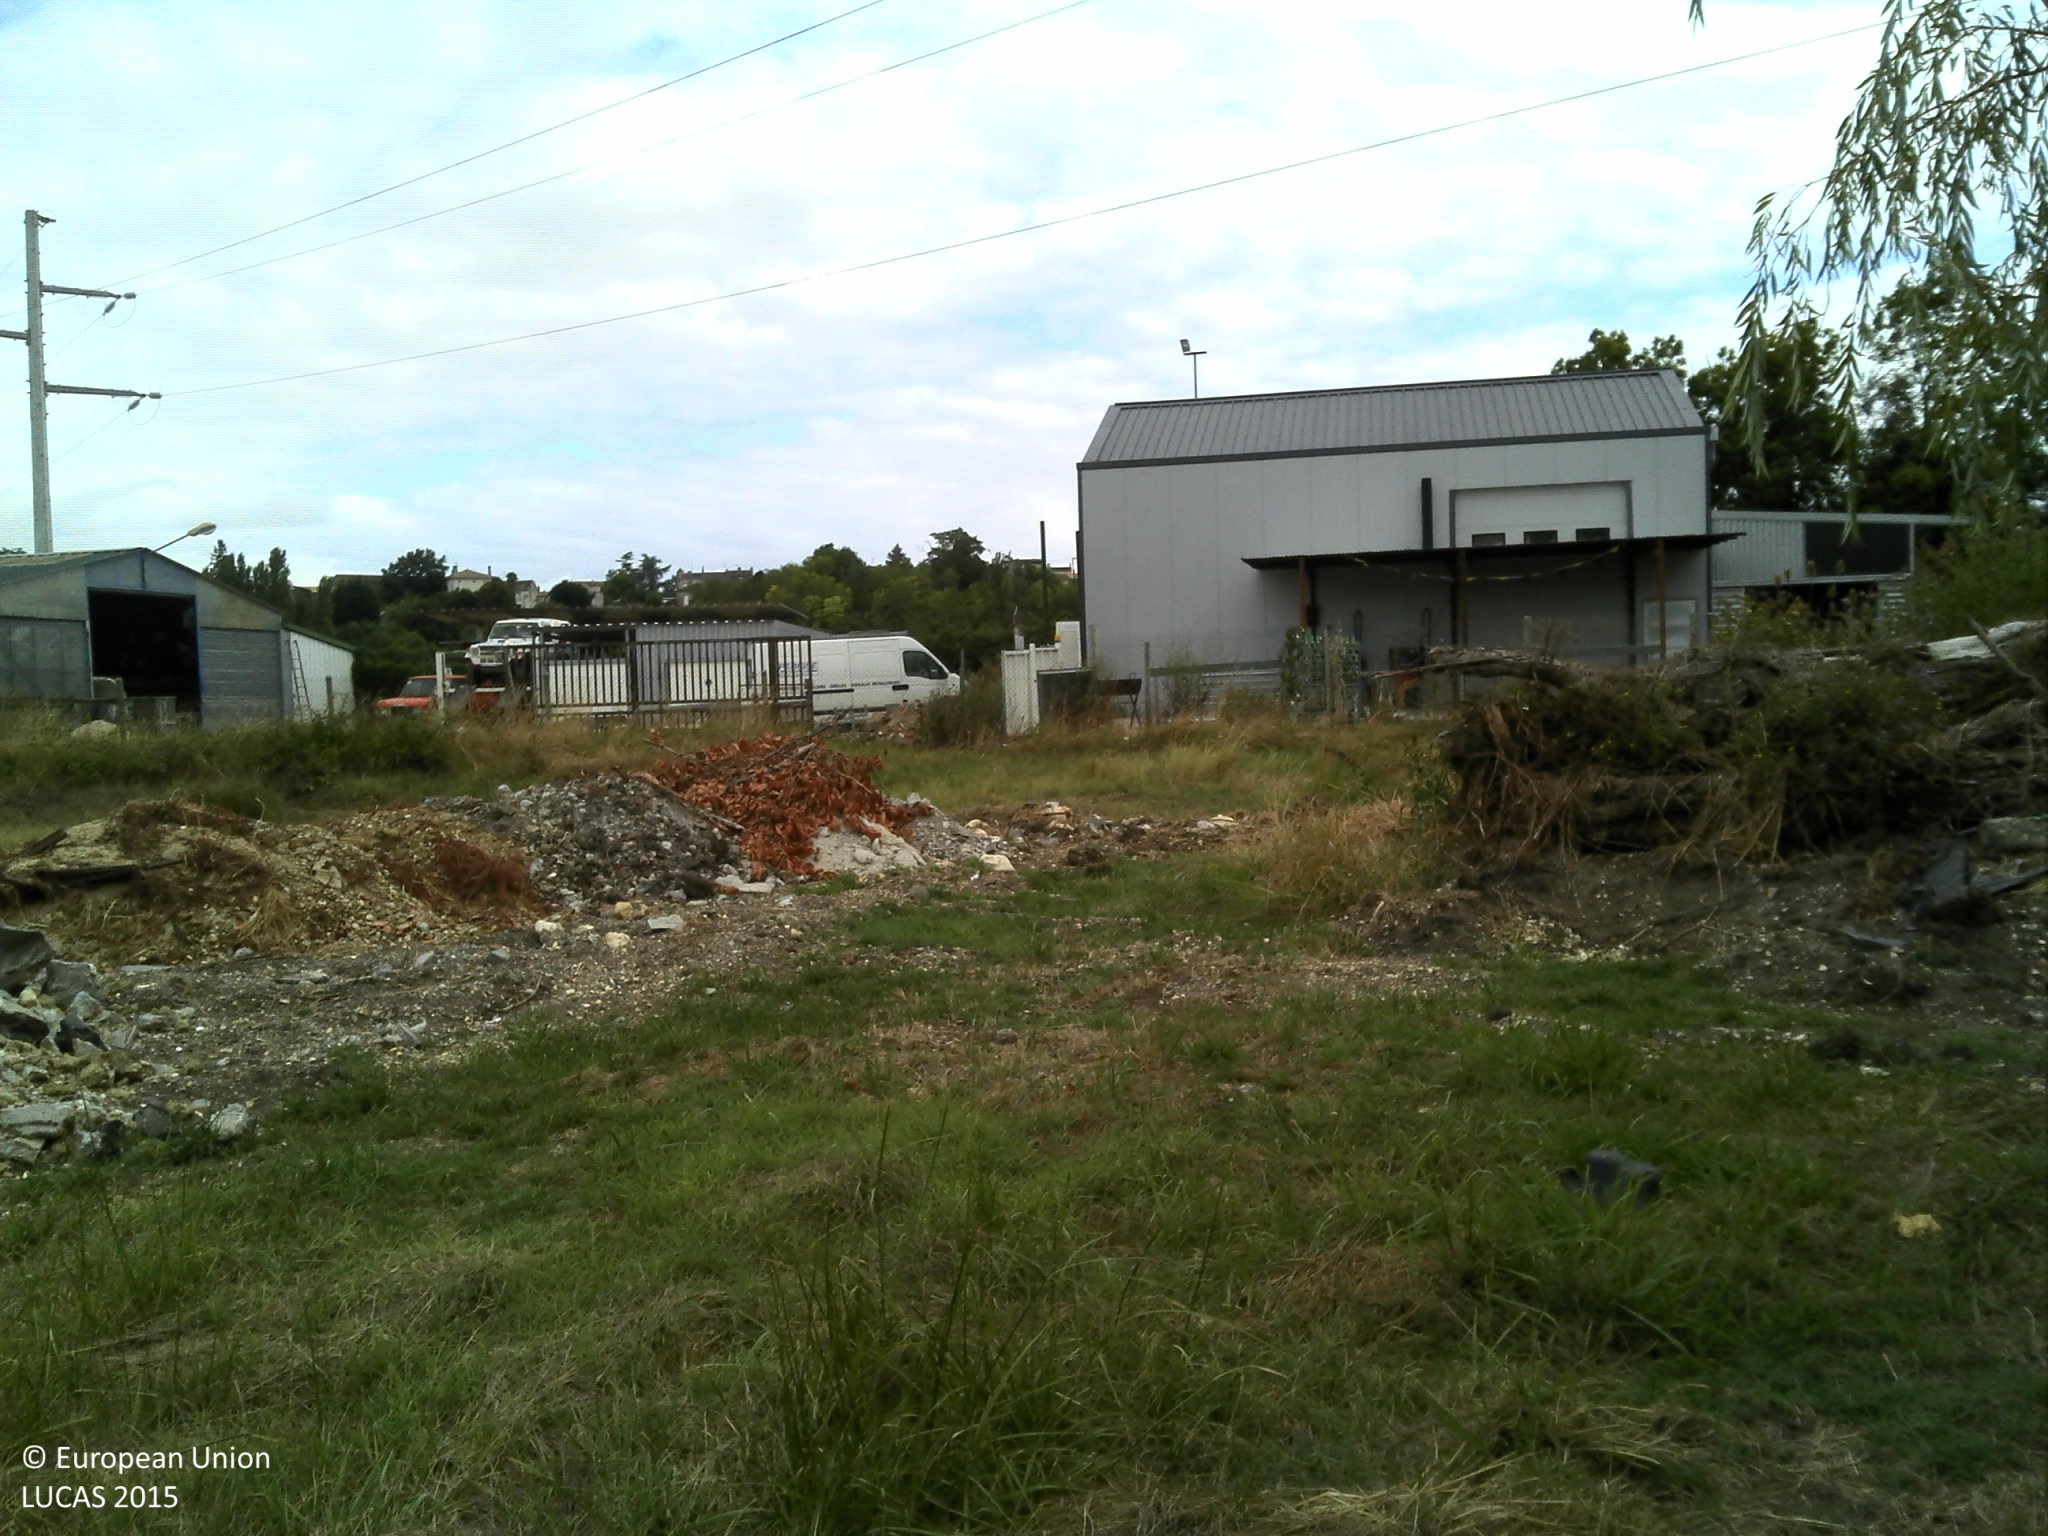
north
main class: Grassland
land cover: Grassland with sparse tree/shrub cover
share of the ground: > 75 %
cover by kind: herbaceous plants 95 %, broadleaved forest trees 5 %
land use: Residential
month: July
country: FR
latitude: 44.9660
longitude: -0.4524
